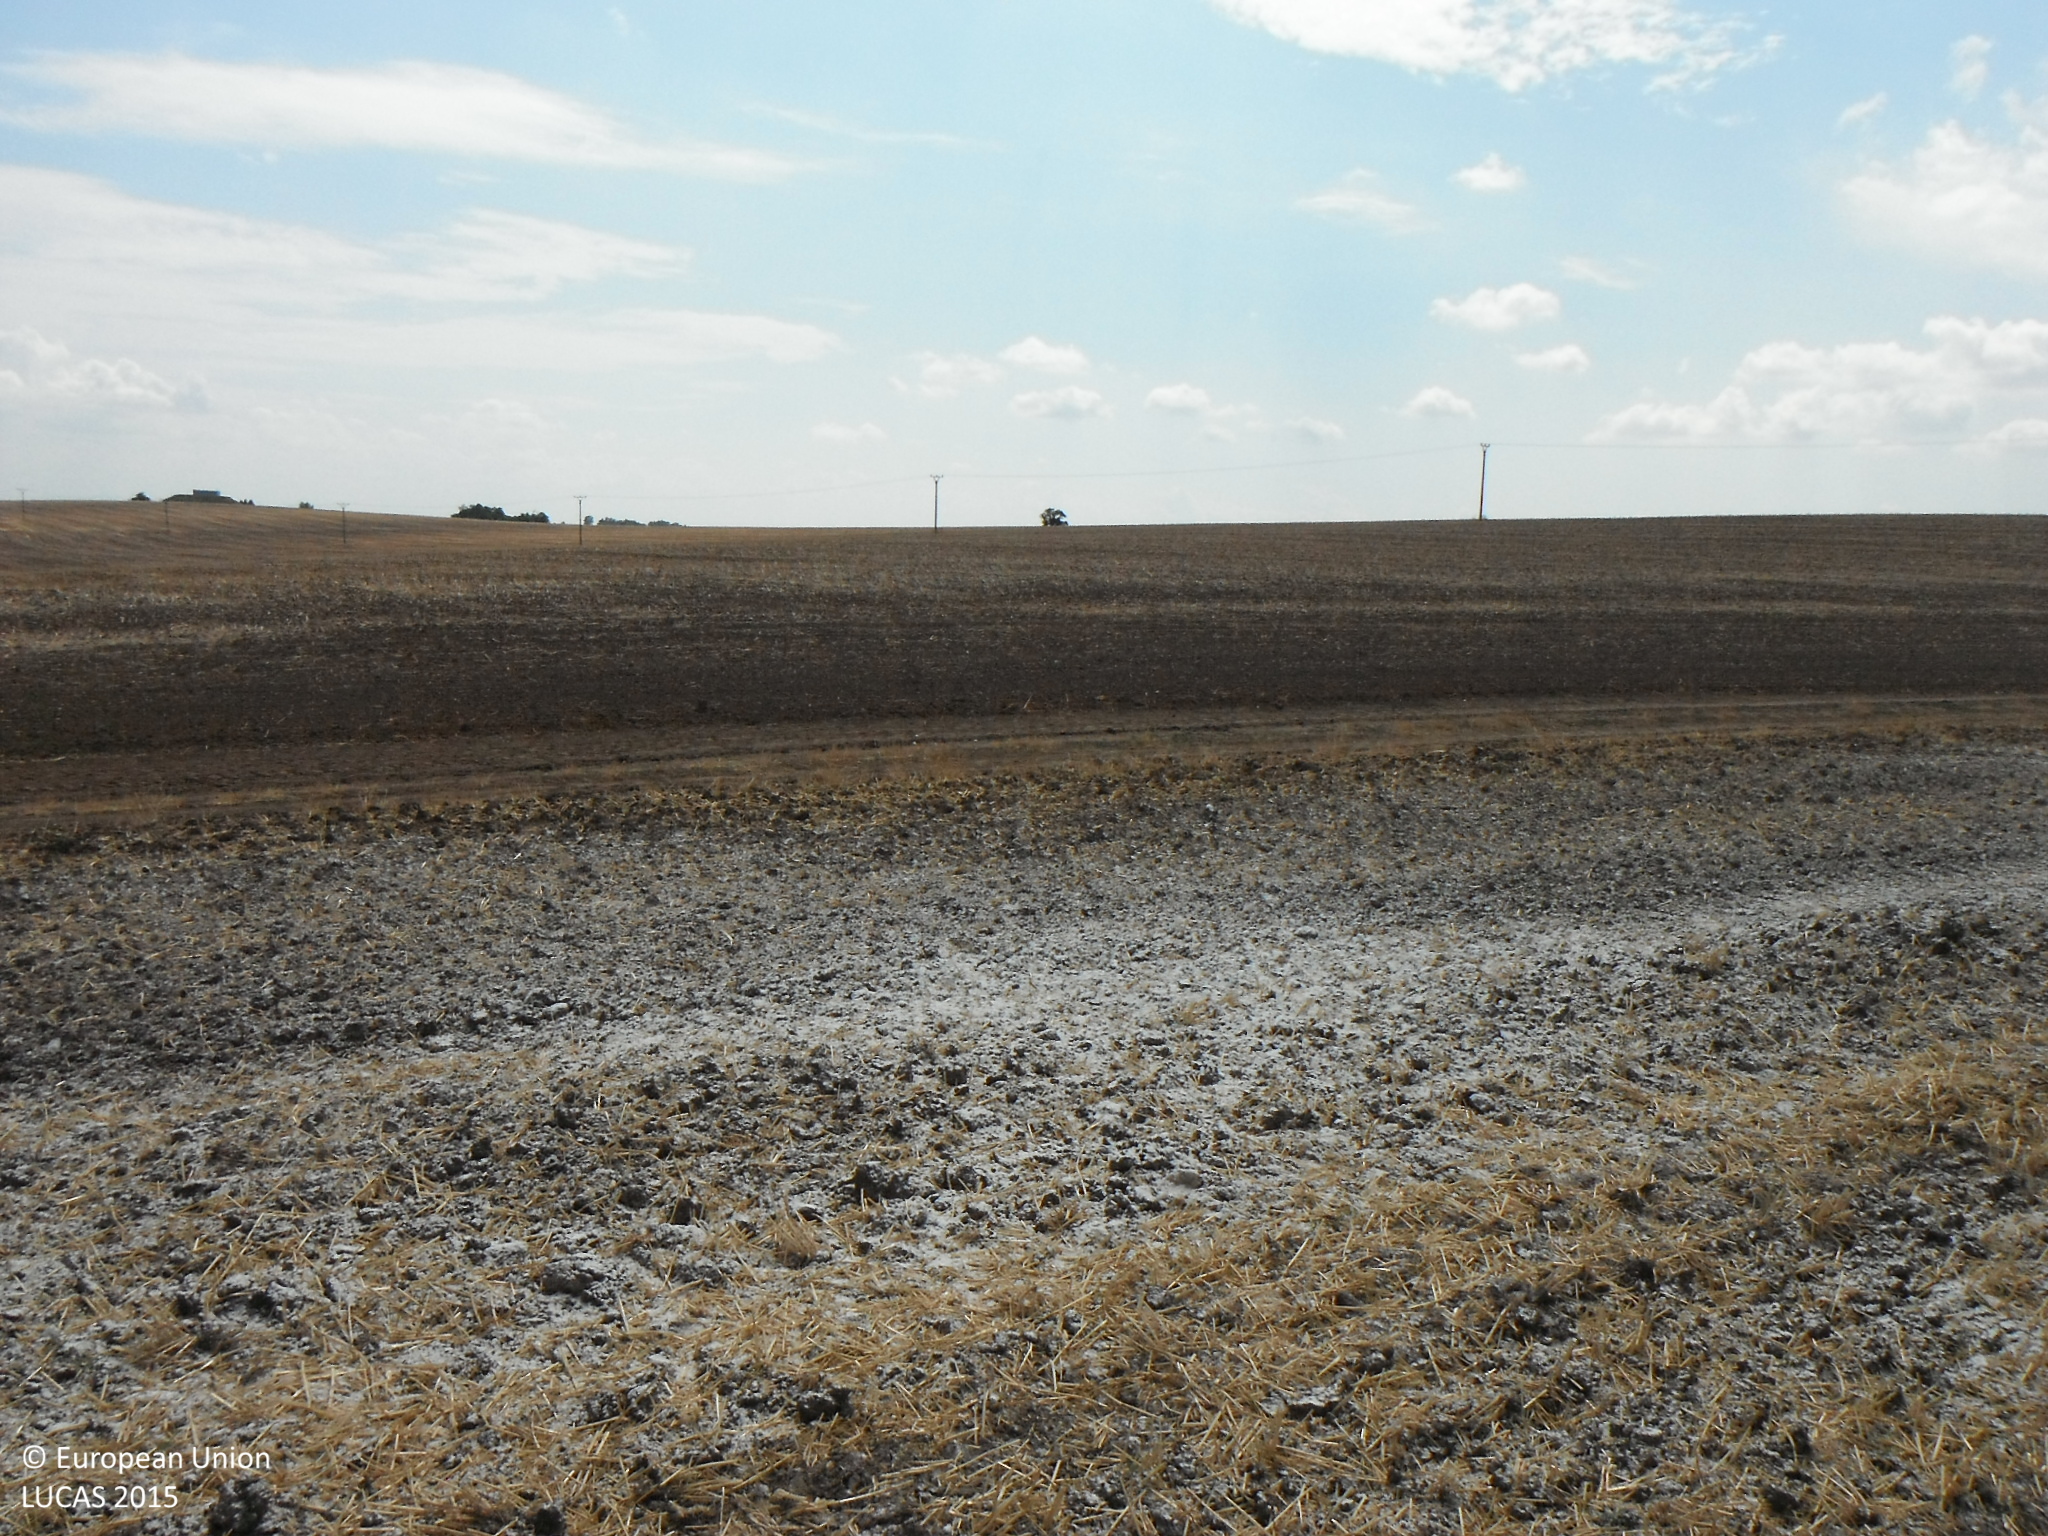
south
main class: Cropland
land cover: Common wheat
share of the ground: 10 - 25 %
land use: Agriculture (excluding fallow land and kitchen gardens)
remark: Harvested field
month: August
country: SK
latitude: 48.1346
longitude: 18.4408
